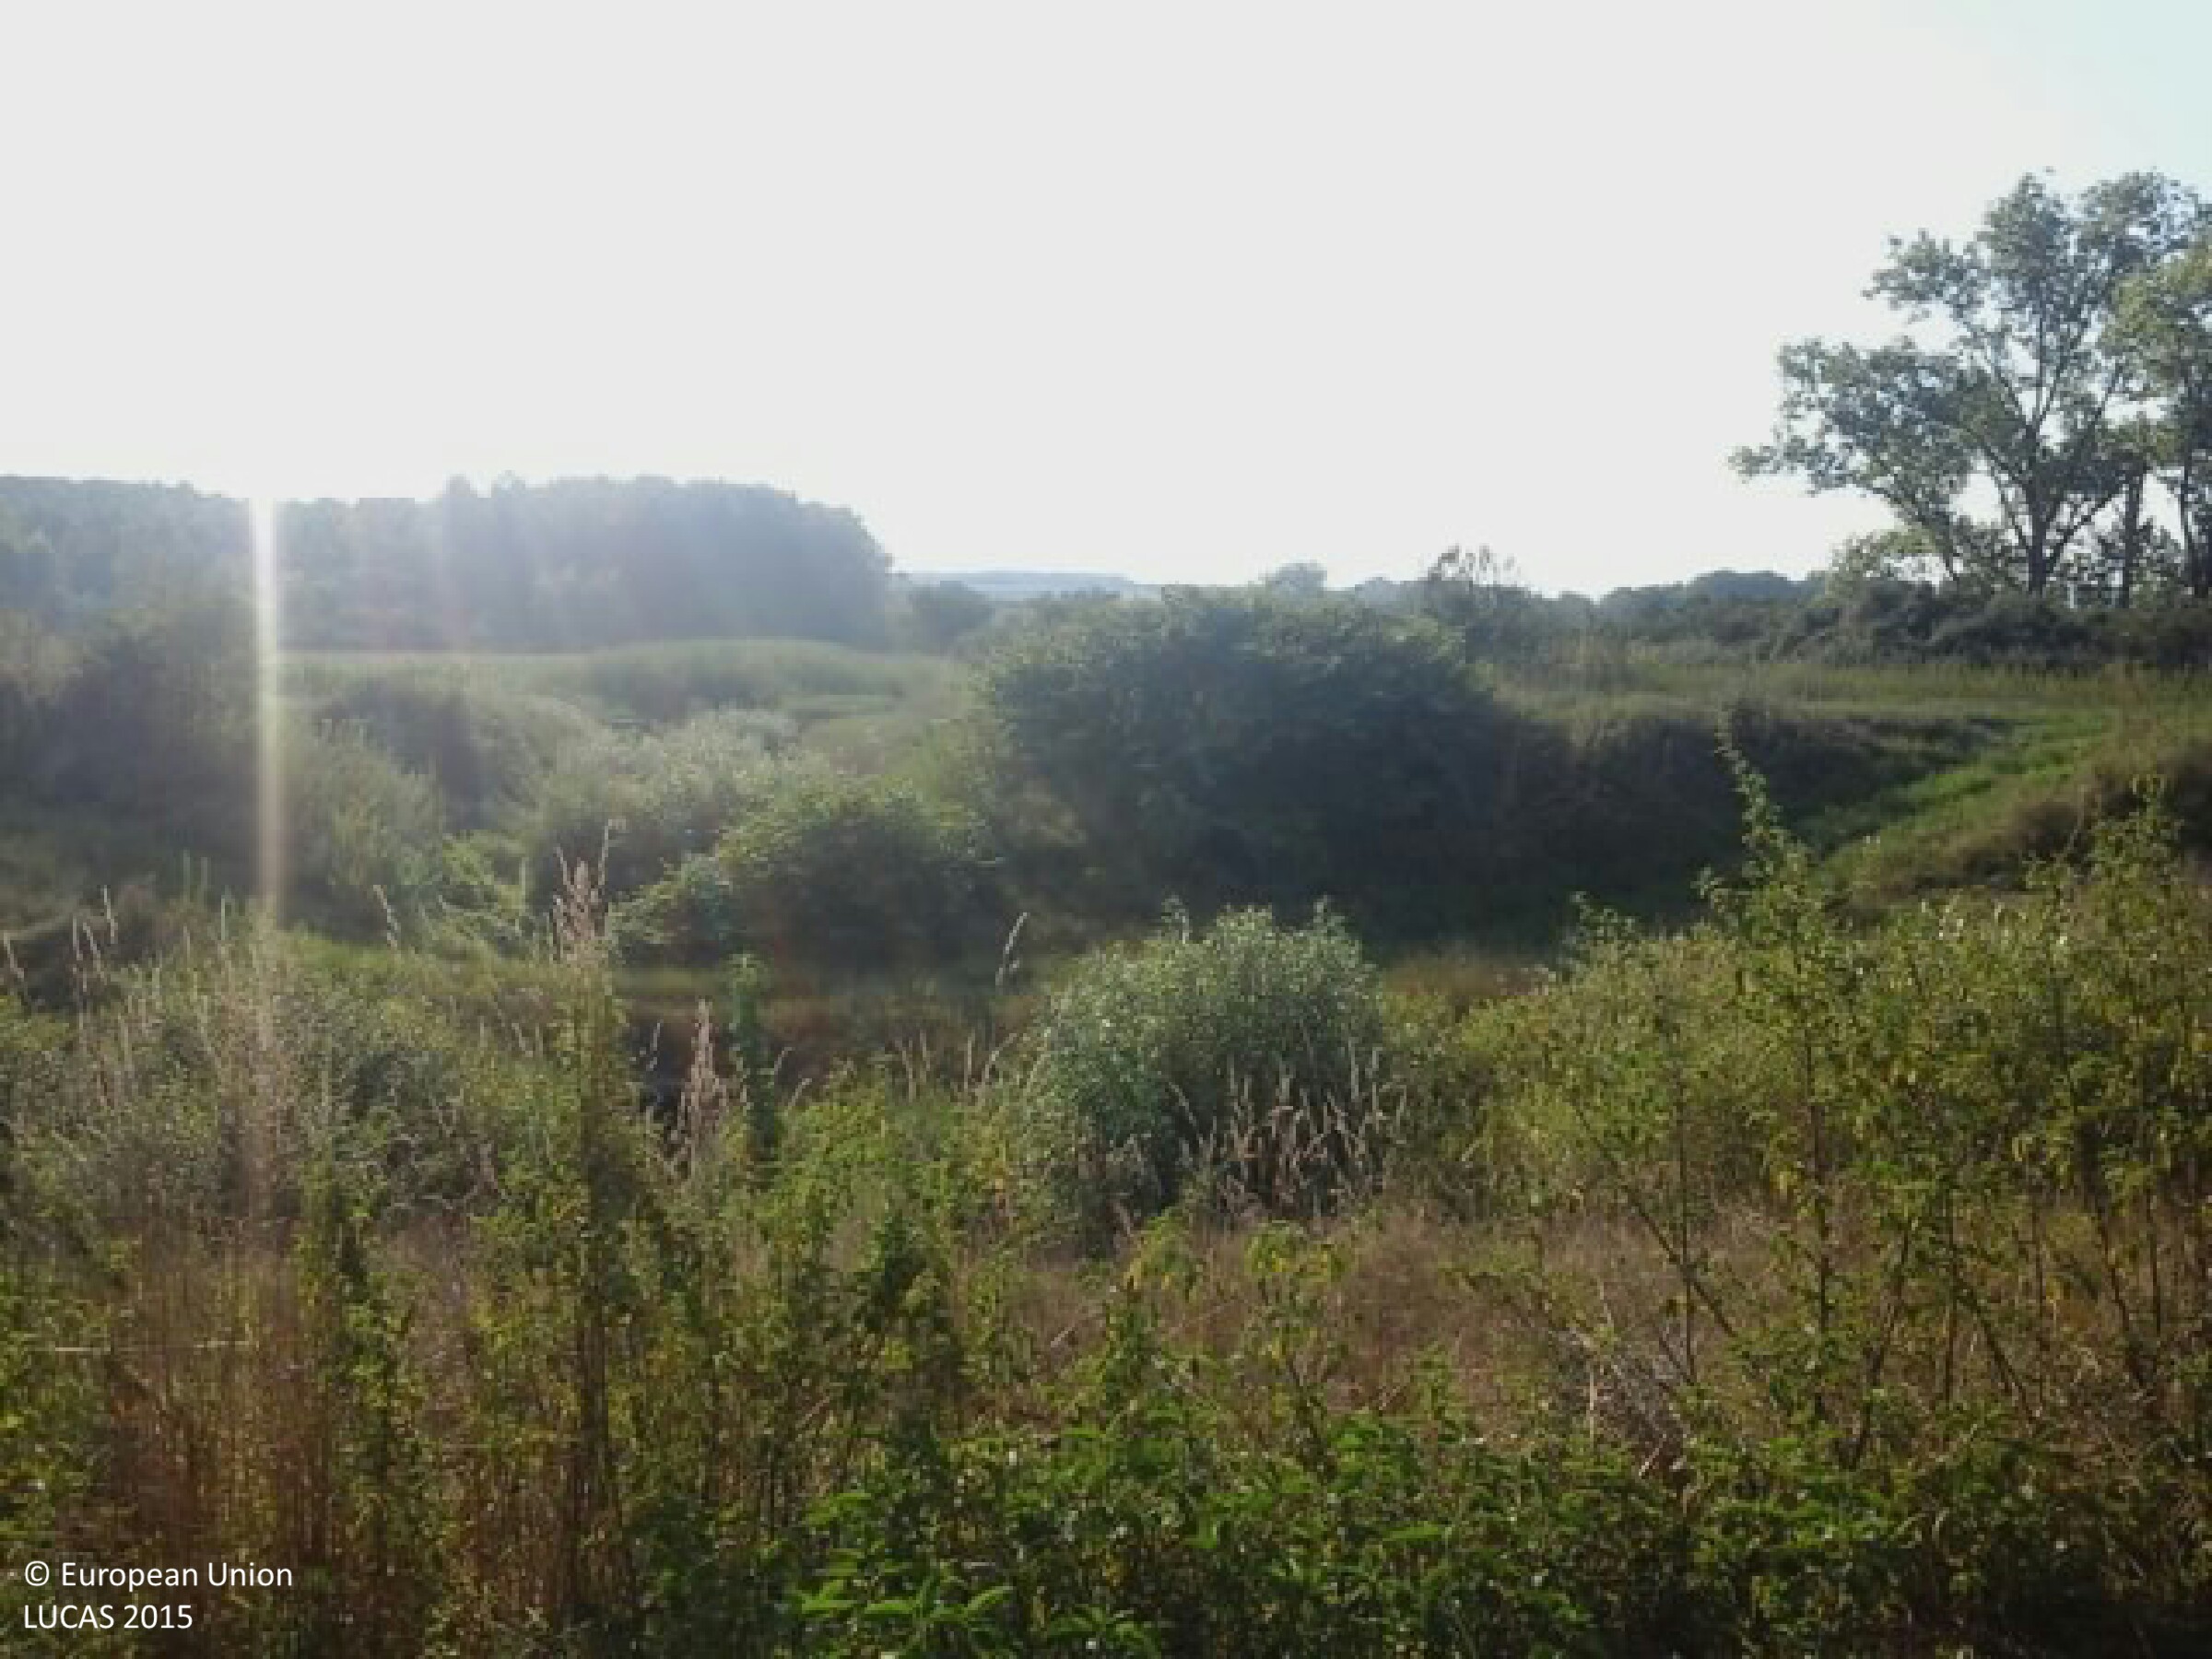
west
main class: Cropland
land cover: Maize
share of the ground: > 75 %
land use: Agriculture (excluding fallow land and kitchen gardens)
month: August
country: HU
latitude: 46.2776
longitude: 18.1182
